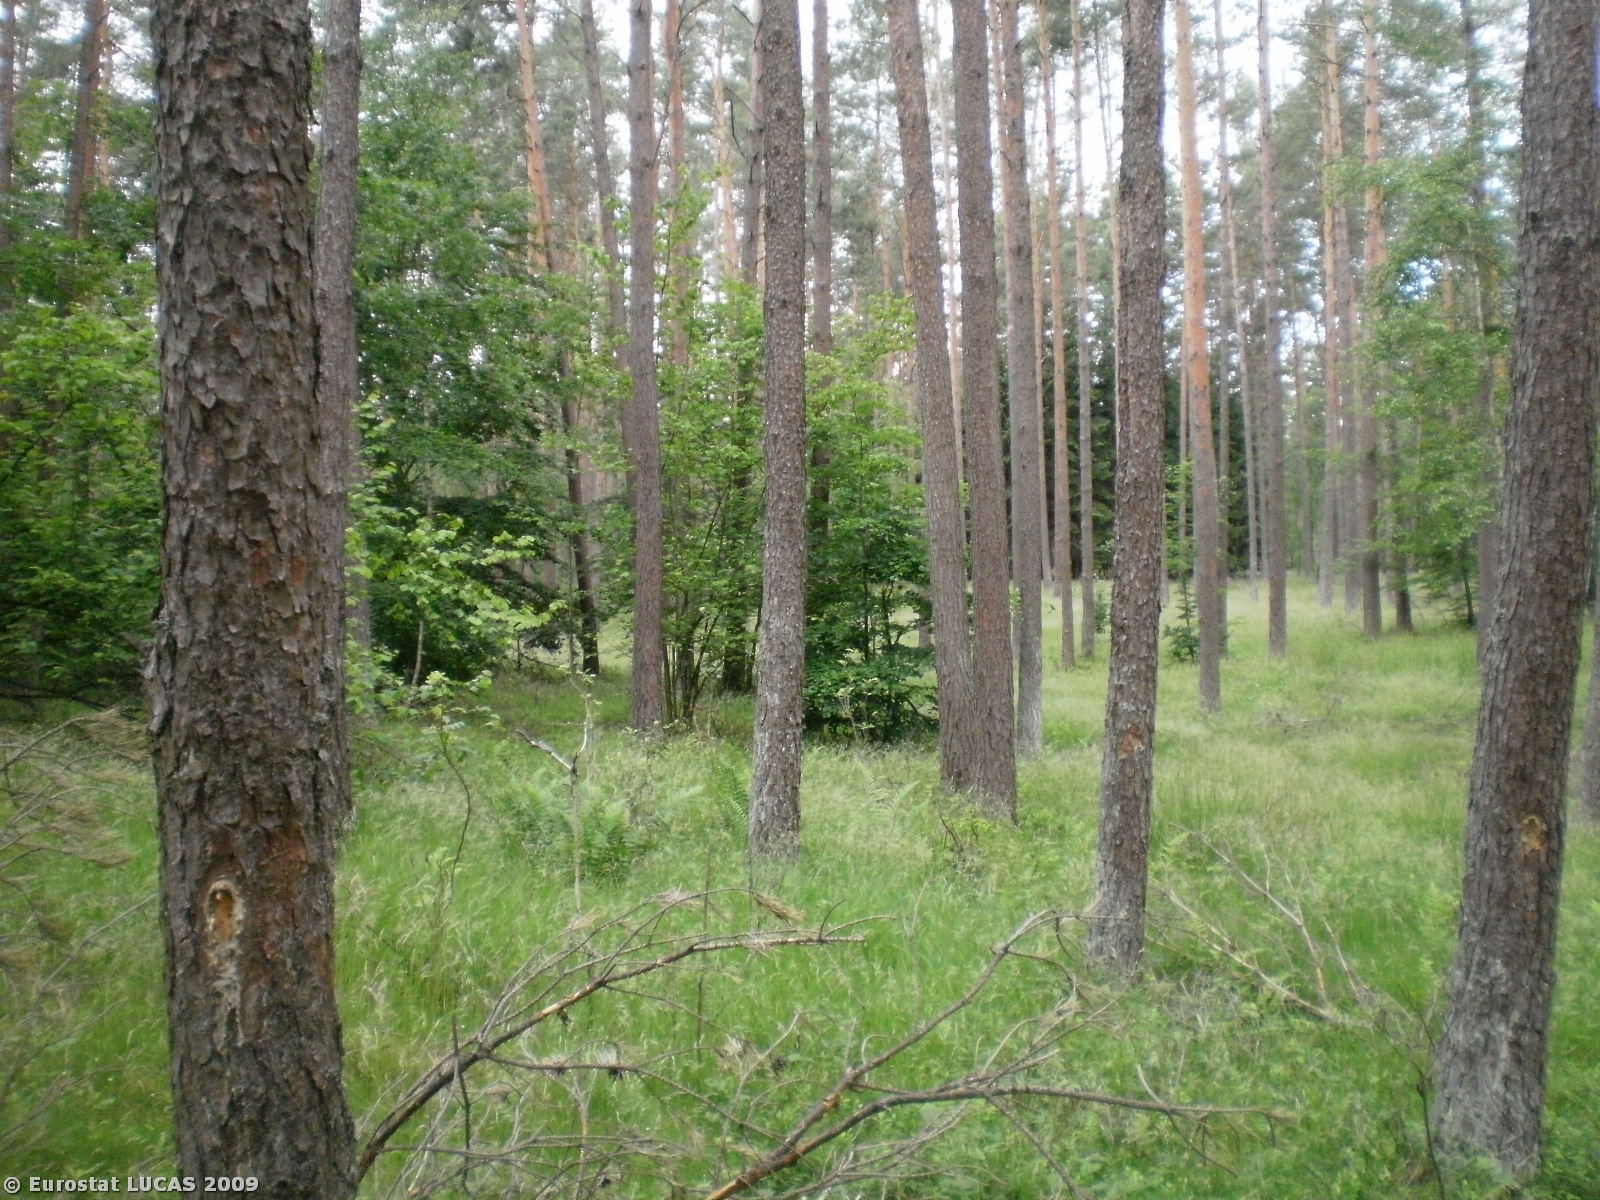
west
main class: Woodland
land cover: Coniferous woodland
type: hemiboreal forest and nemoral coniferous forest and mixed broadleaved-coniferous forest
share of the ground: > 75 %
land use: Forestry
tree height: > 5 m
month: June
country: PL
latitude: 53.7584
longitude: 19.8740
